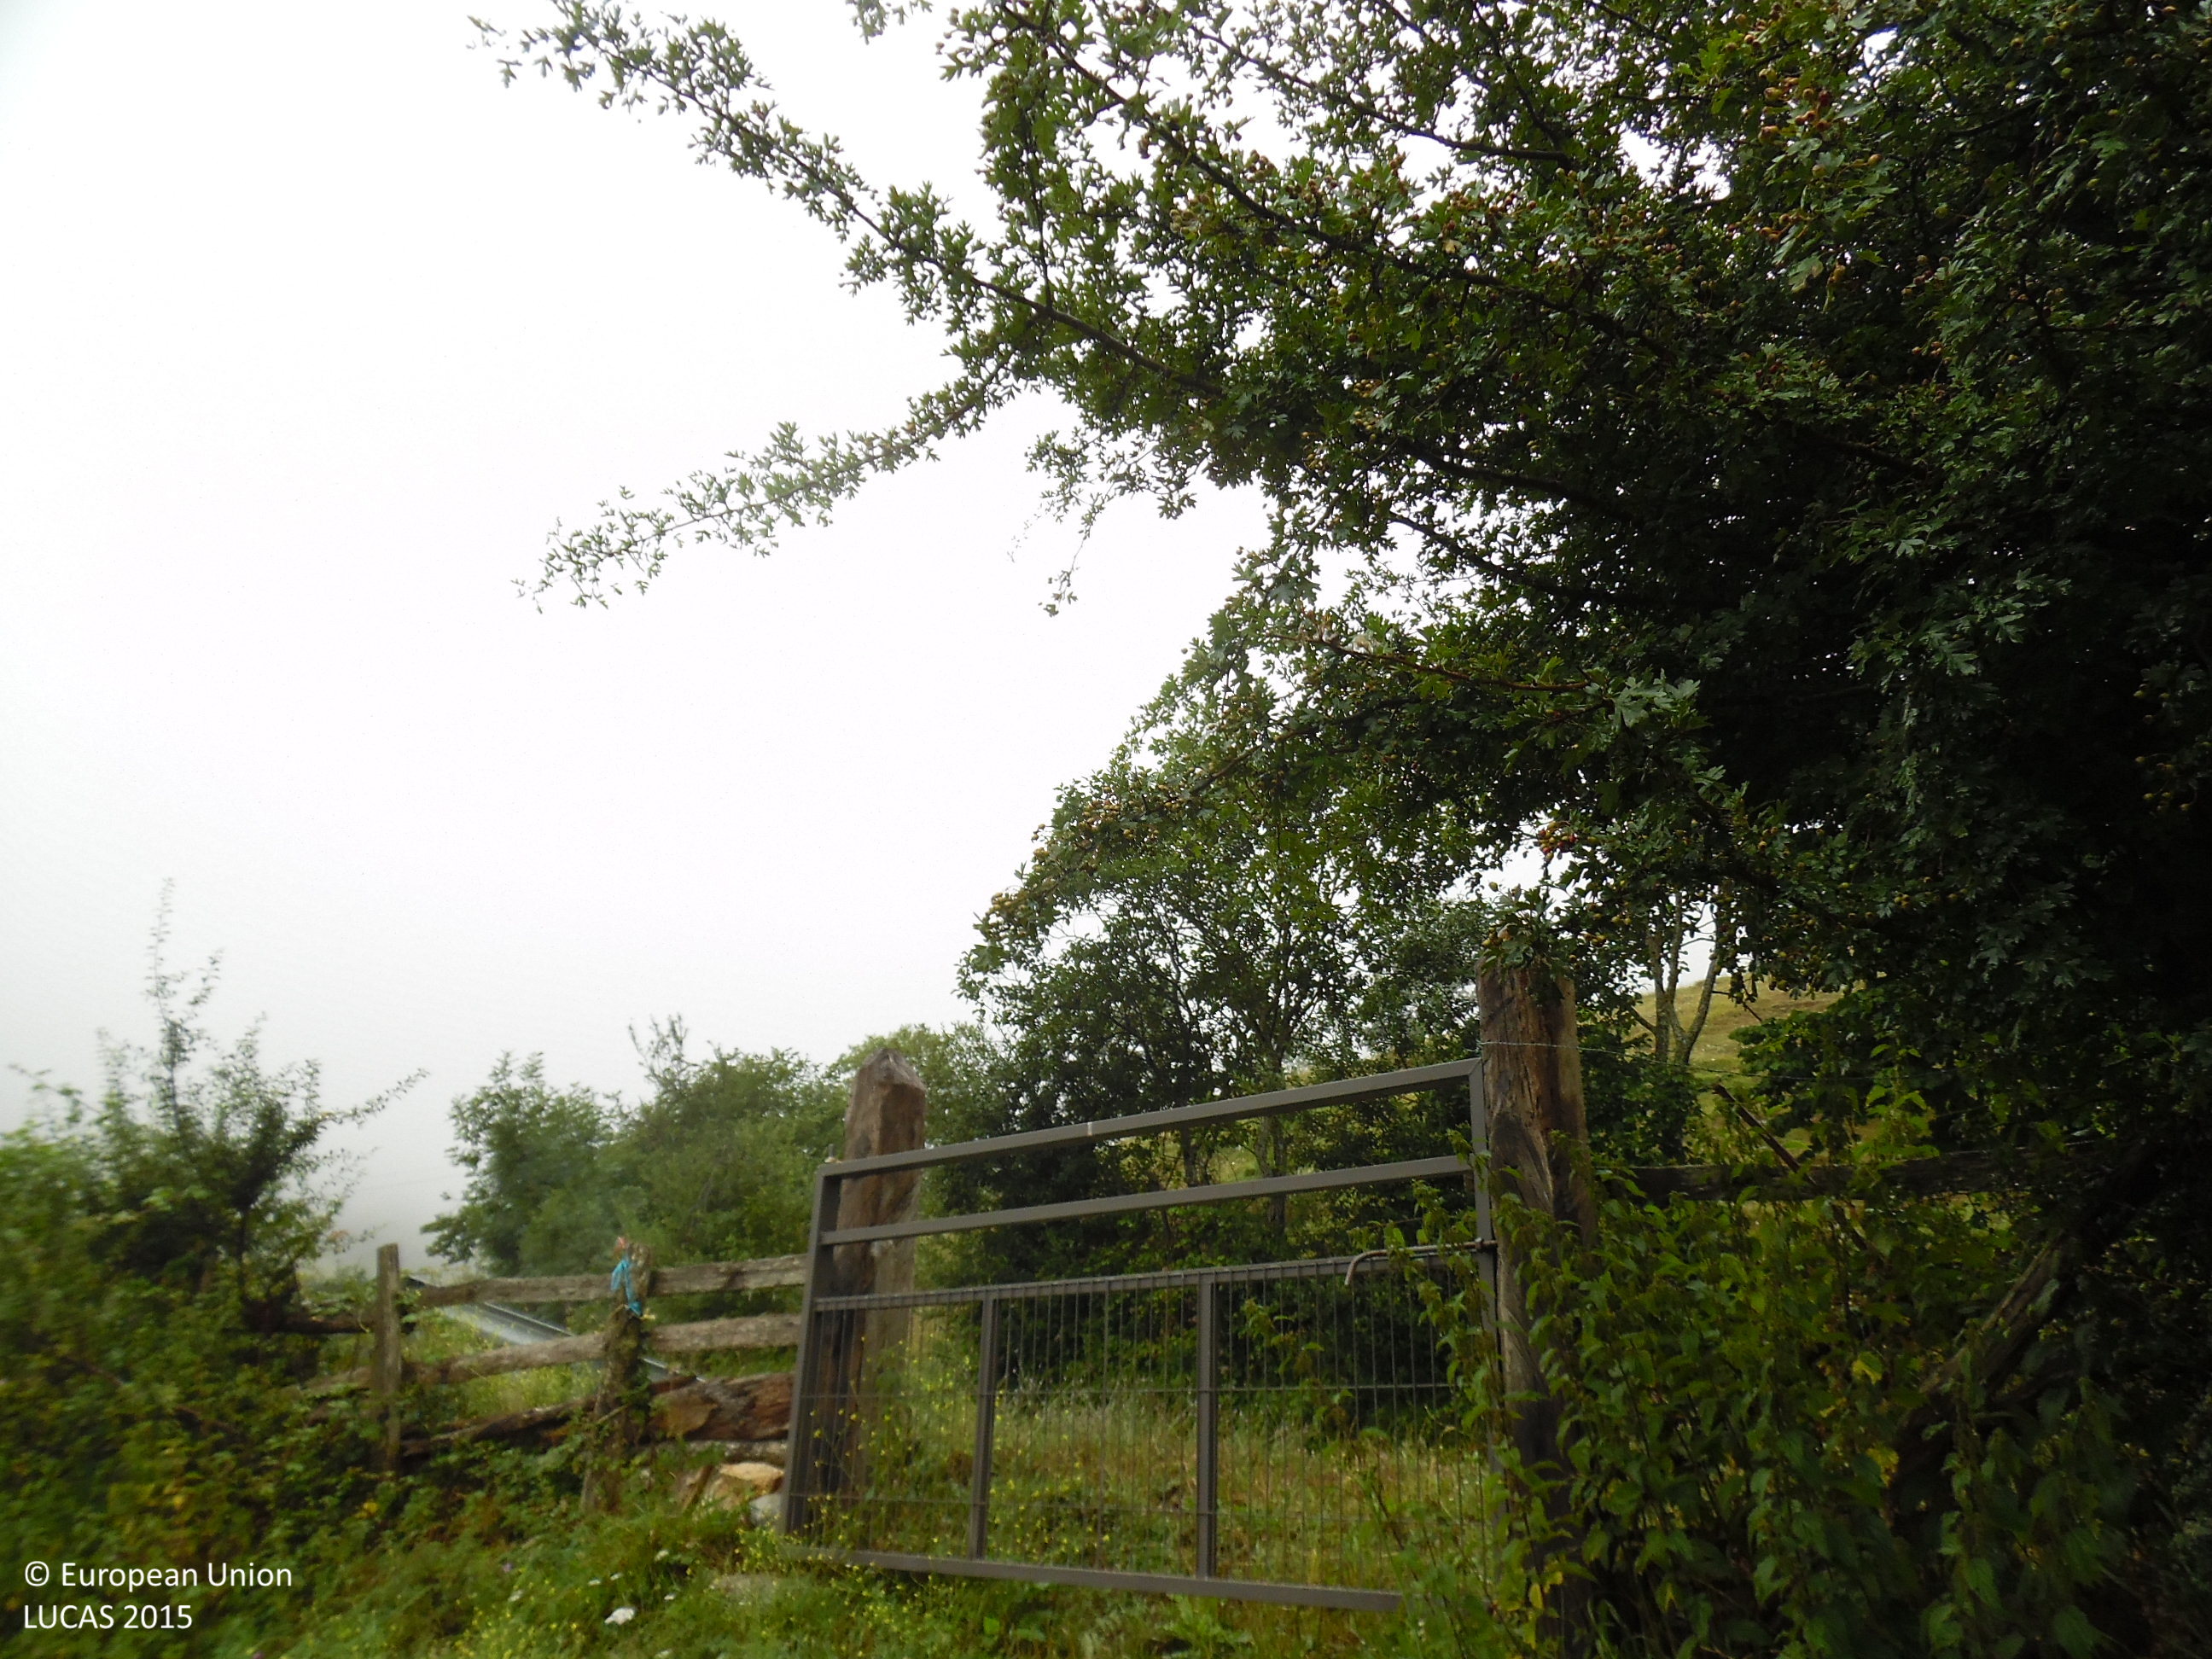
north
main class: Grassland
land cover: Grassland without tree/shrub cover
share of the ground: > 75 %
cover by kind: herbaceous plants 95 %, consolidated bare surface 5 %
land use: Agriculture (excluding fallow land and kitchen gardens)
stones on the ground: < 10 %
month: July
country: ES
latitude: 43.0229
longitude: -5.9027
